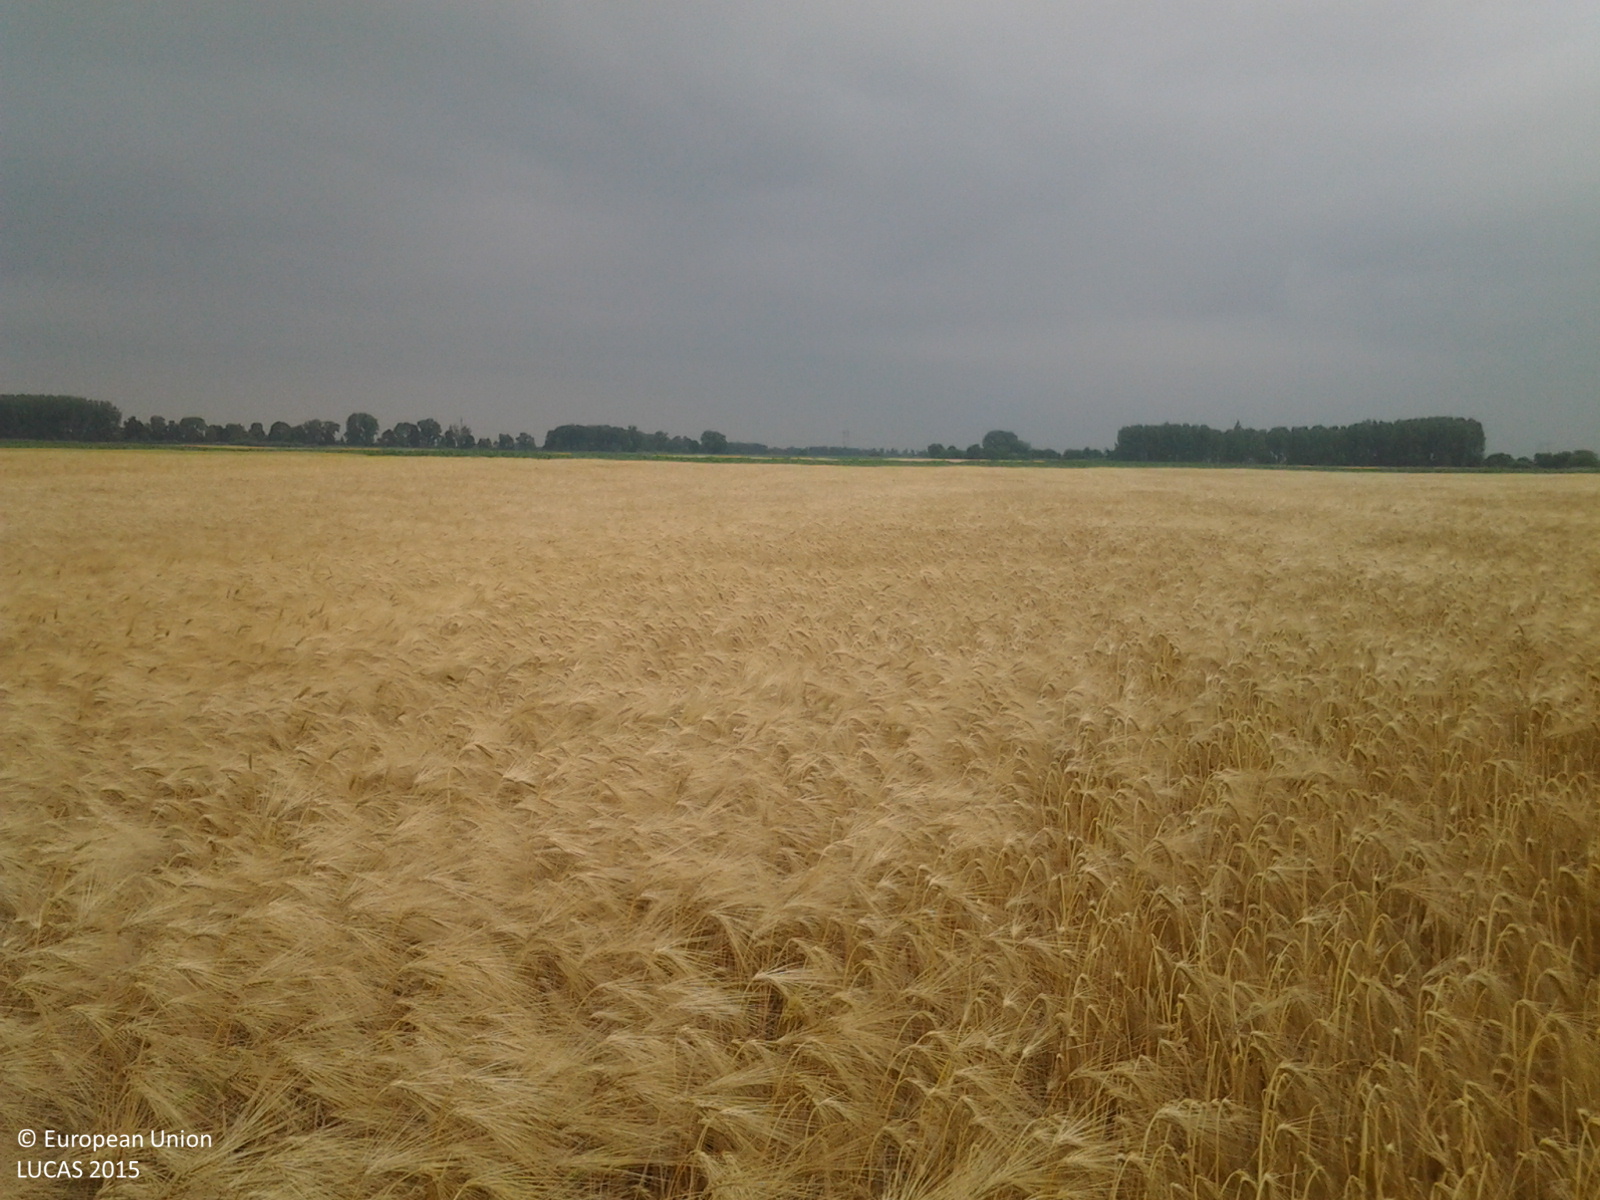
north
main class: Cropland
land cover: Barley
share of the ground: > 75 %
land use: Agriculture (excluding fallow land and kitchen gardens)
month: June
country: HU
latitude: 46.4616
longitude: 18.9849
